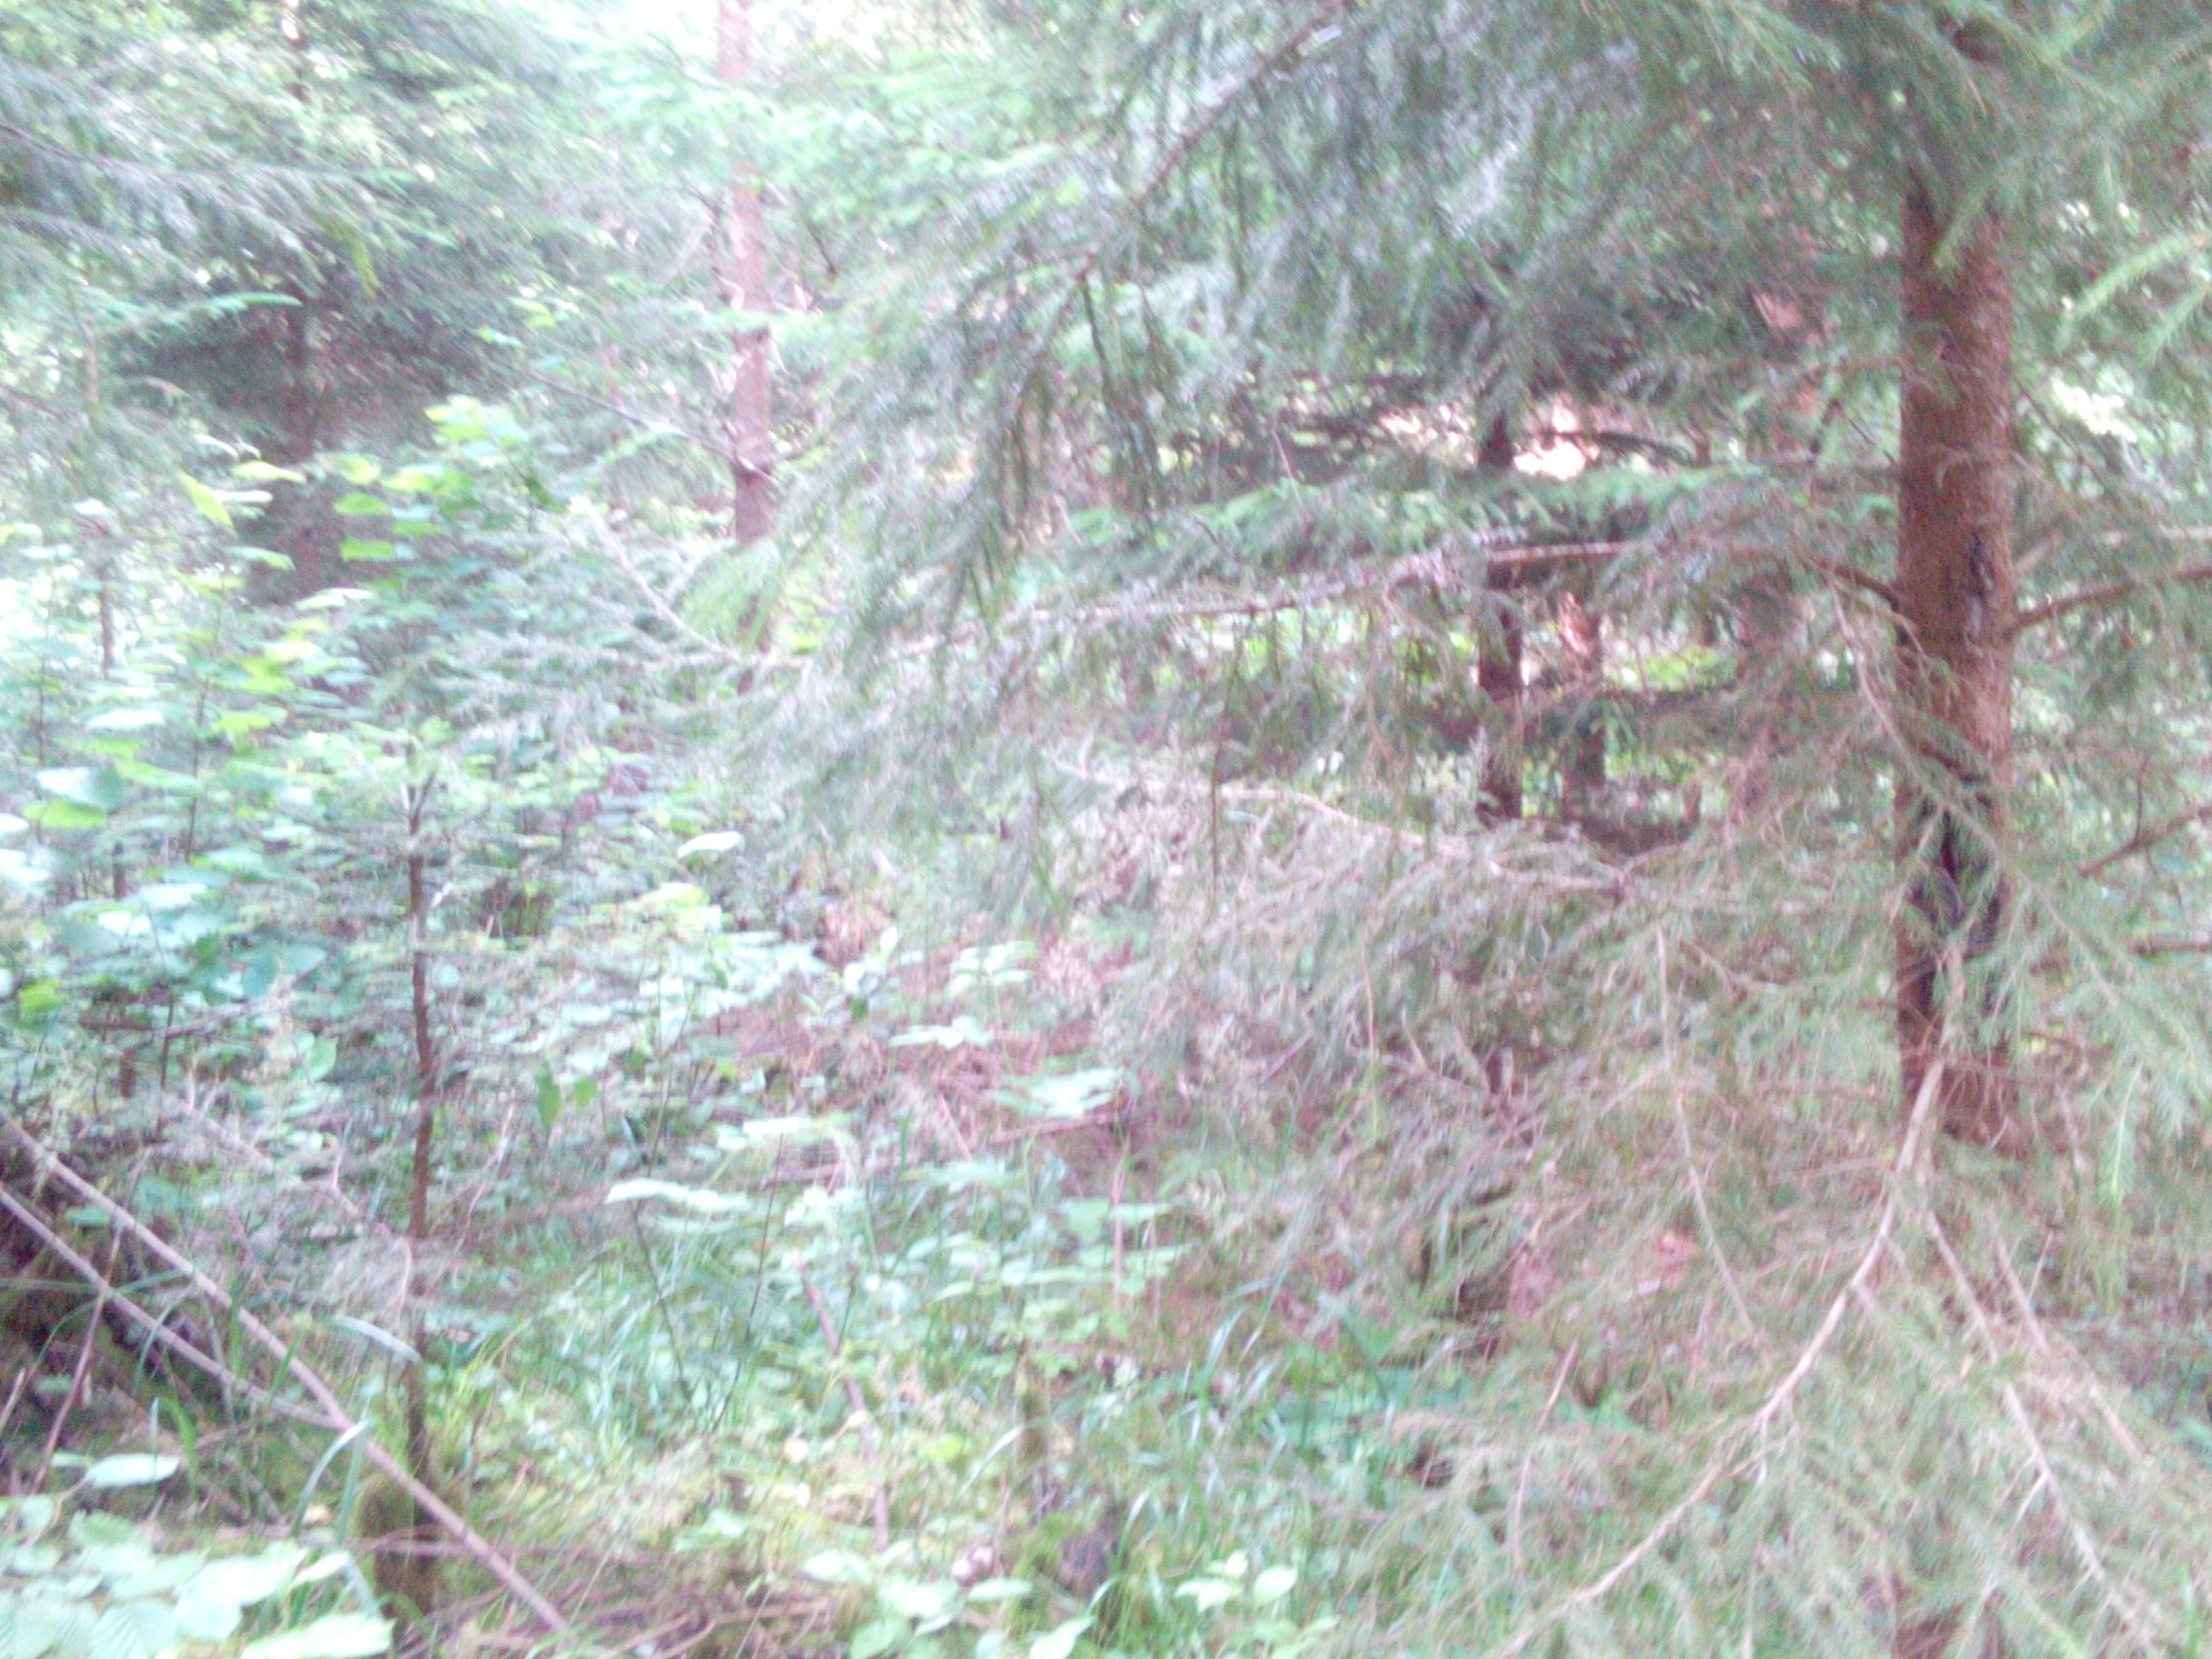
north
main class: Woodland
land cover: Spruce dominated coniferous woodland
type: hemiboreal forest and nemoral coniferous forest and mixed broadleaved-coniferous forest
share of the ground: 50 - 75 %
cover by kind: coniferous forest trees 65 %, herbaceous plants 20 %, broadleaved forest trees 15 %
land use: Forestry
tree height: > 5 m
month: July
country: LV
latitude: 56.6140
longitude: 21.2984
